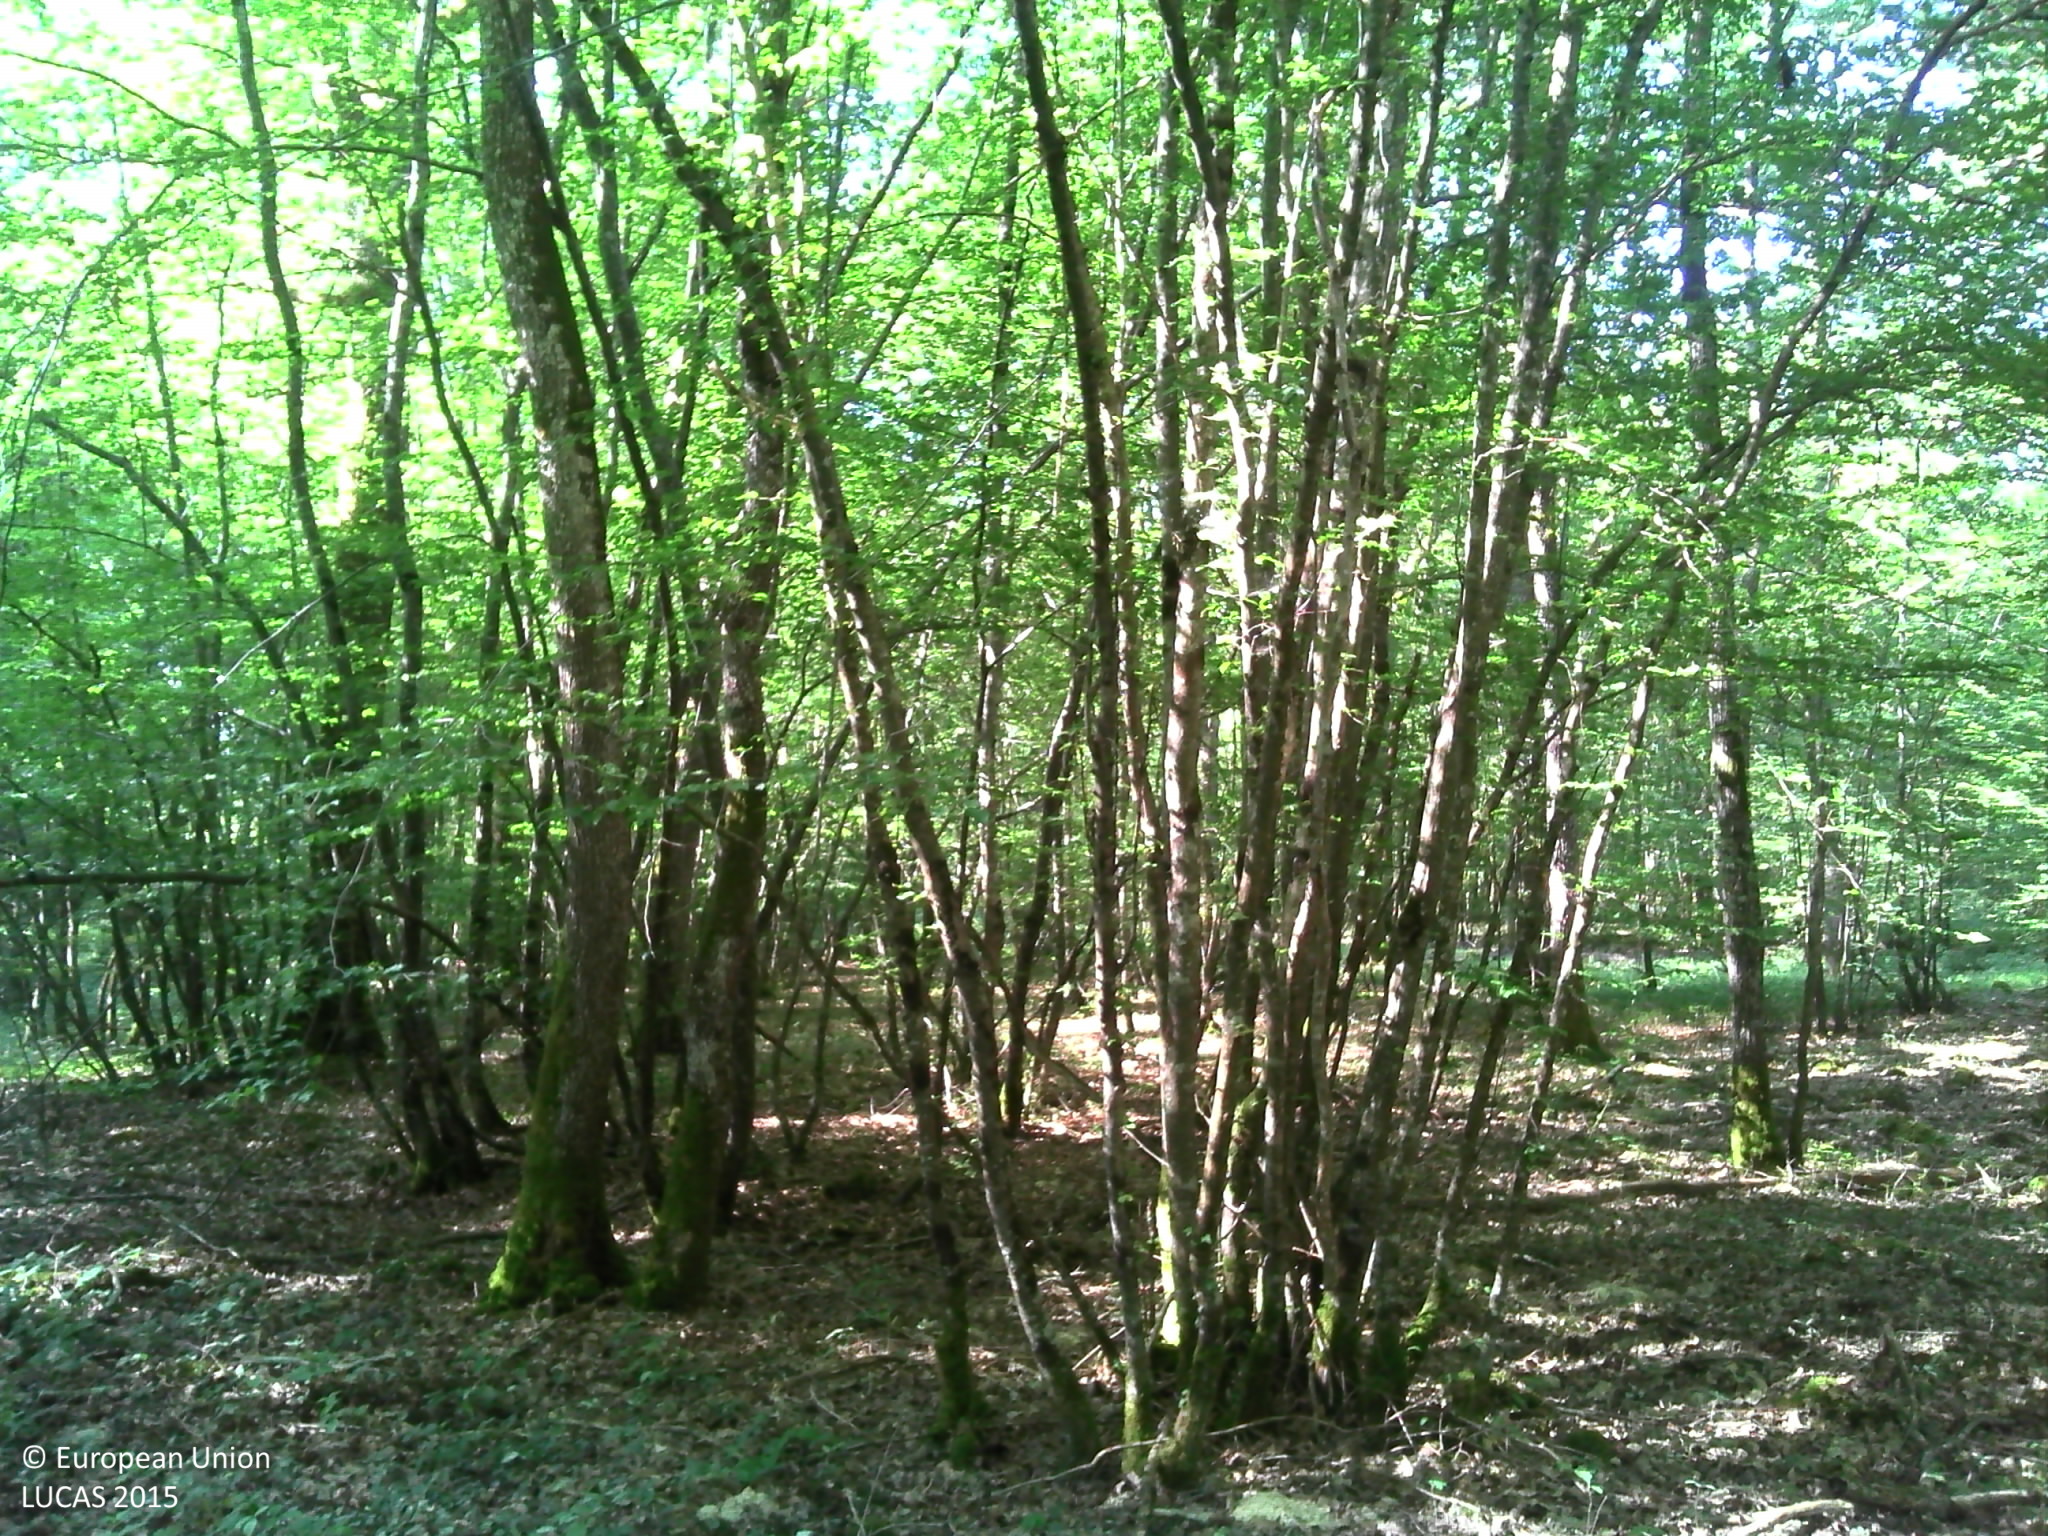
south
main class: Woodland
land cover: Broadleaved woodland
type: mesophytic deciduous forest
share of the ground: > 75 %
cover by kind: broadleaved forest trees 90 %, unconsolidated bare surface 10 %
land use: Forestry
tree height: > 5 m
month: July
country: FR
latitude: 46.8287
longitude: 3.6141
